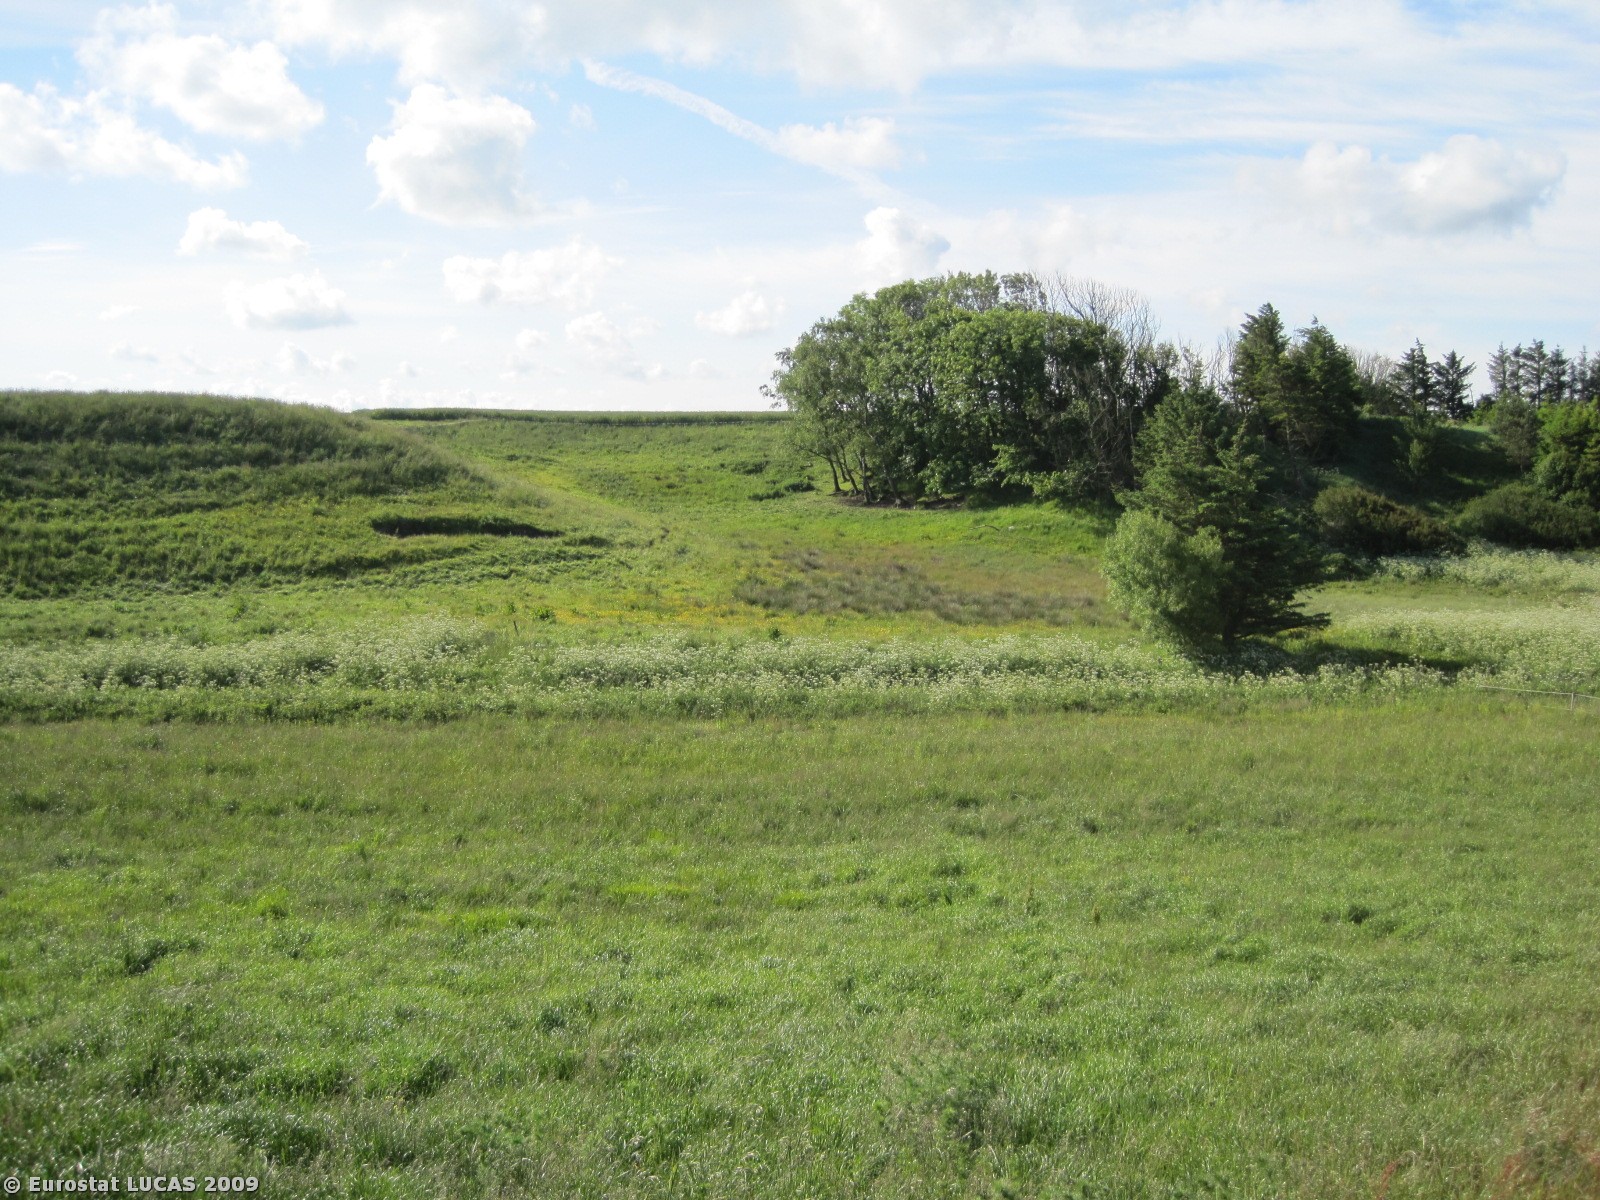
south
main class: Grassland
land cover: Grassland without tree/shrub cover
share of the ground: > 75 %
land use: Agriculture (excluding fallow land and kitchen gardens)
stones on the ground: < 10 %
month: June
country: DK
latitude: 57.4461
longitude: 9.8836
